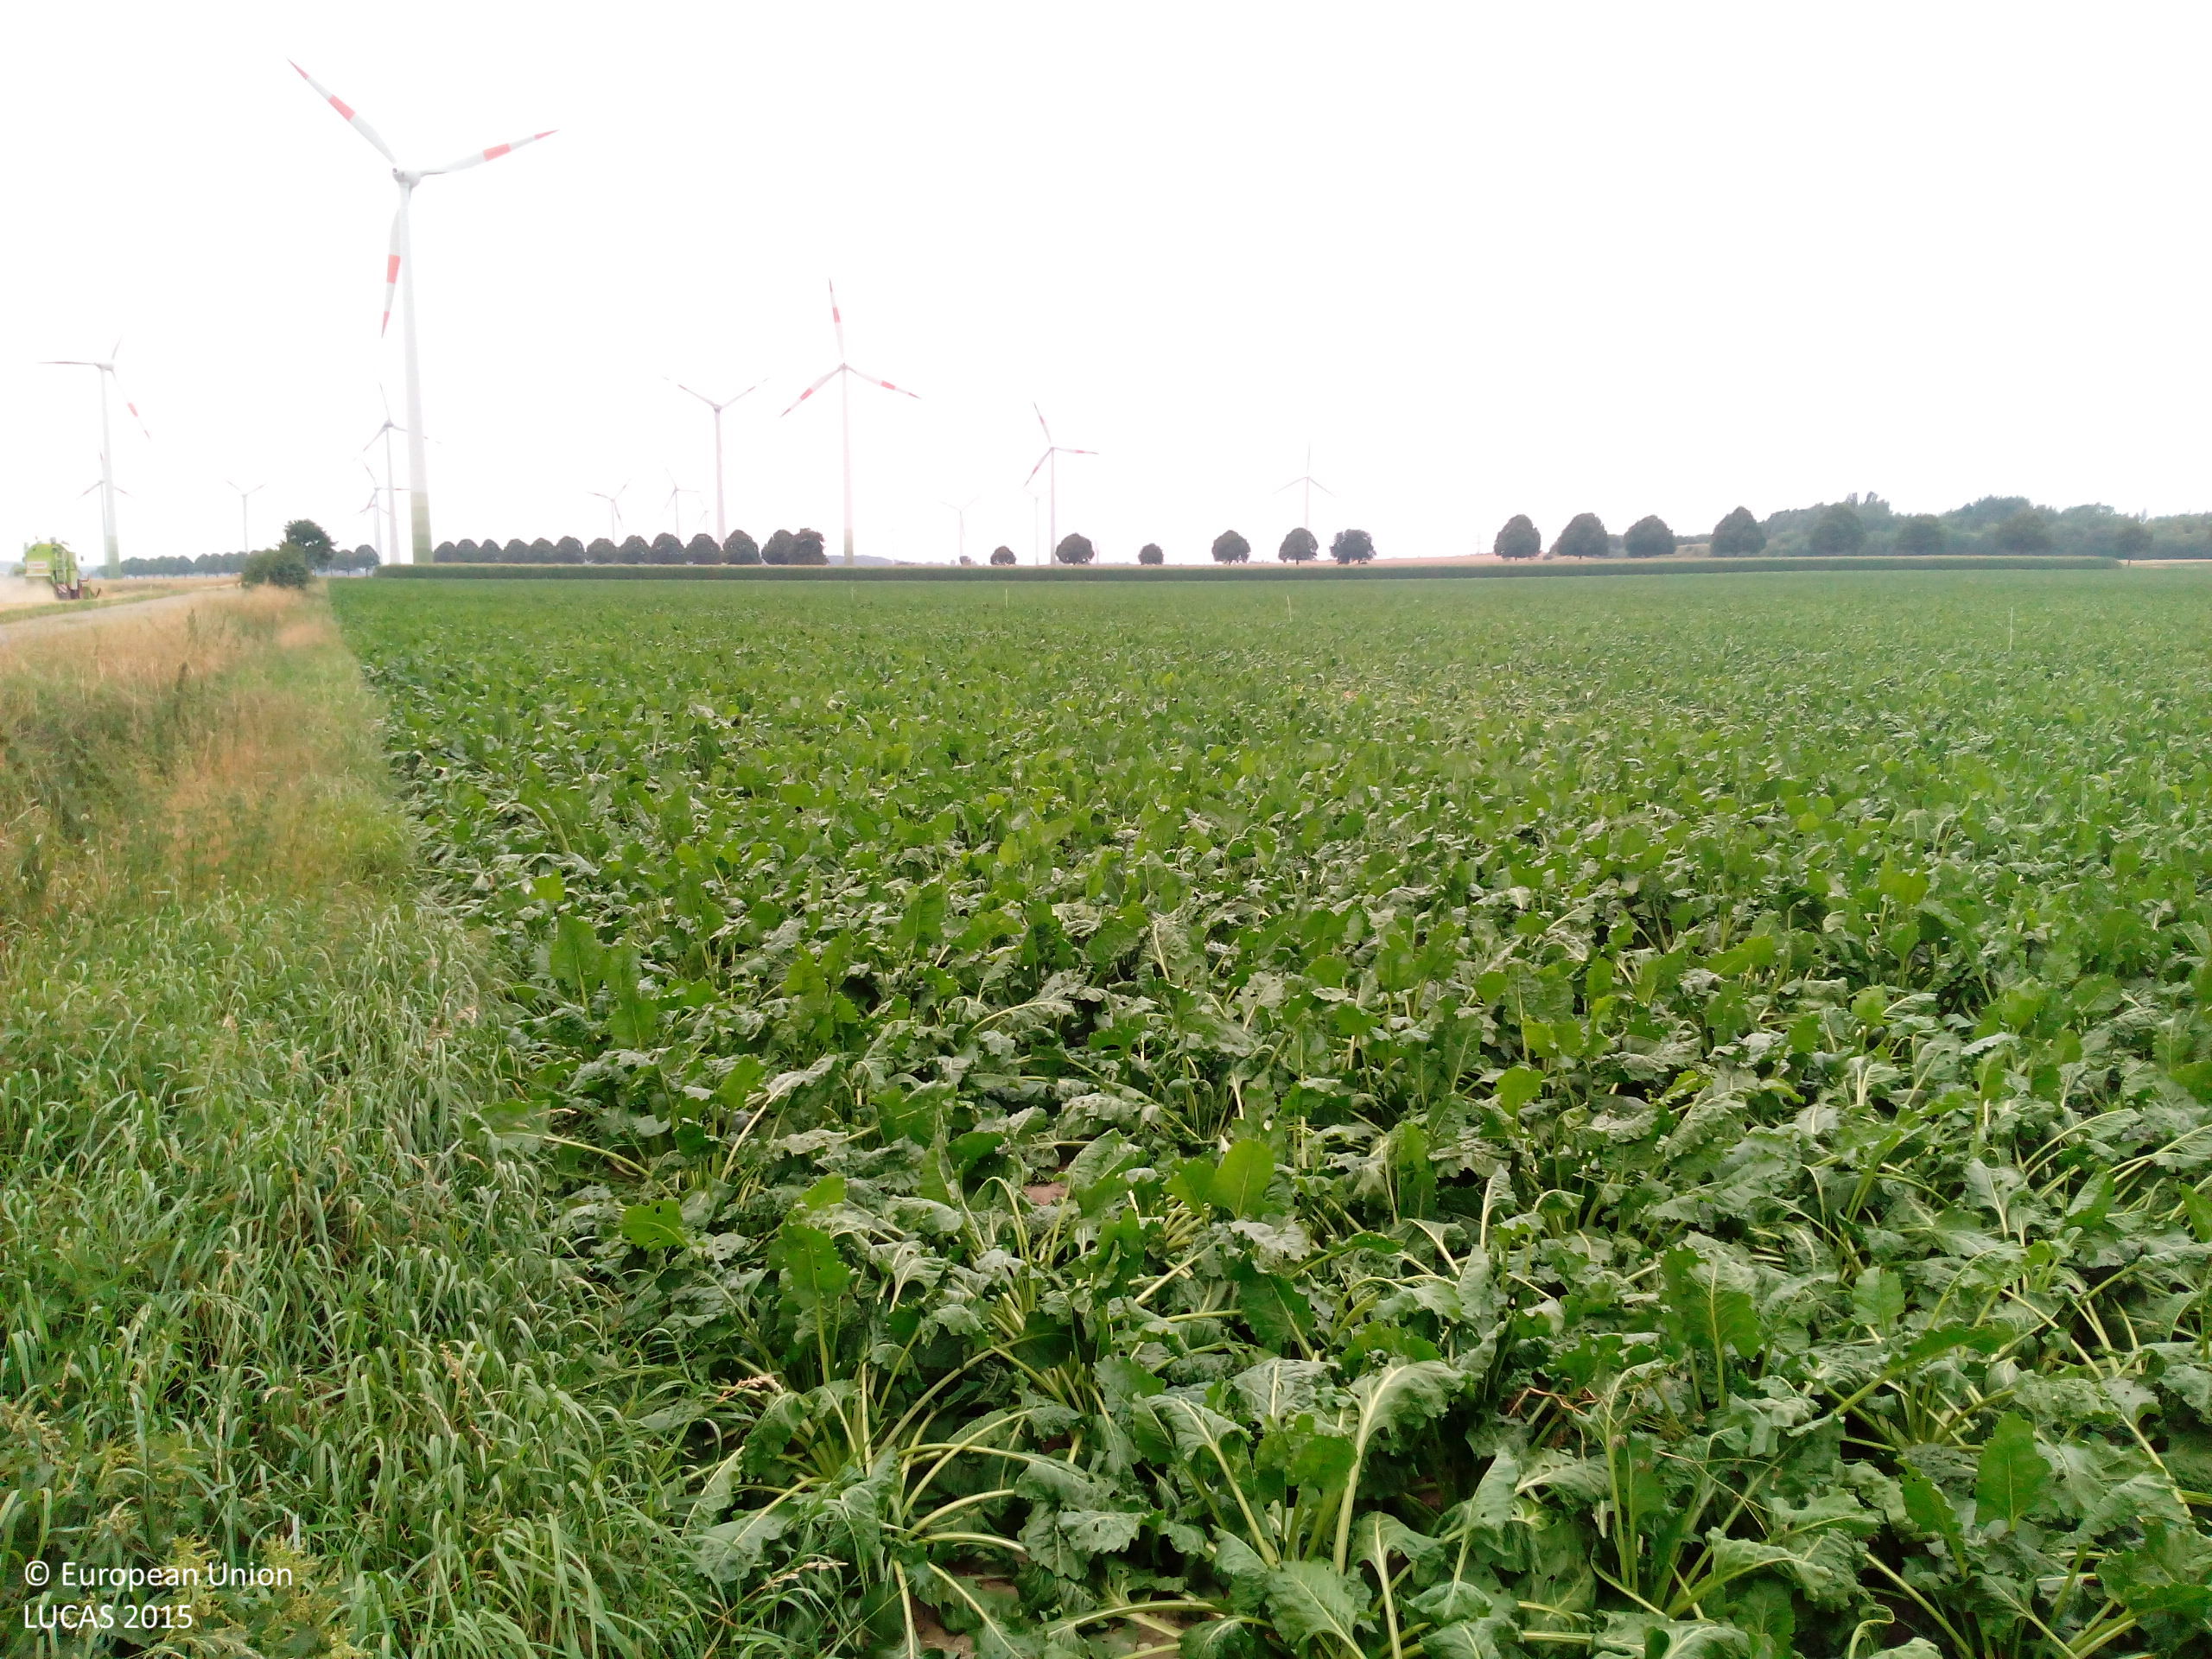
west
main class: Cropland
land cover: Sugar beet
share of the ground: > 75 %
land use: Agriculture (excluding fallow land and kitchen gardens)
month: August
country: DE
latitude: 52.1794
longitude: 10.2778
